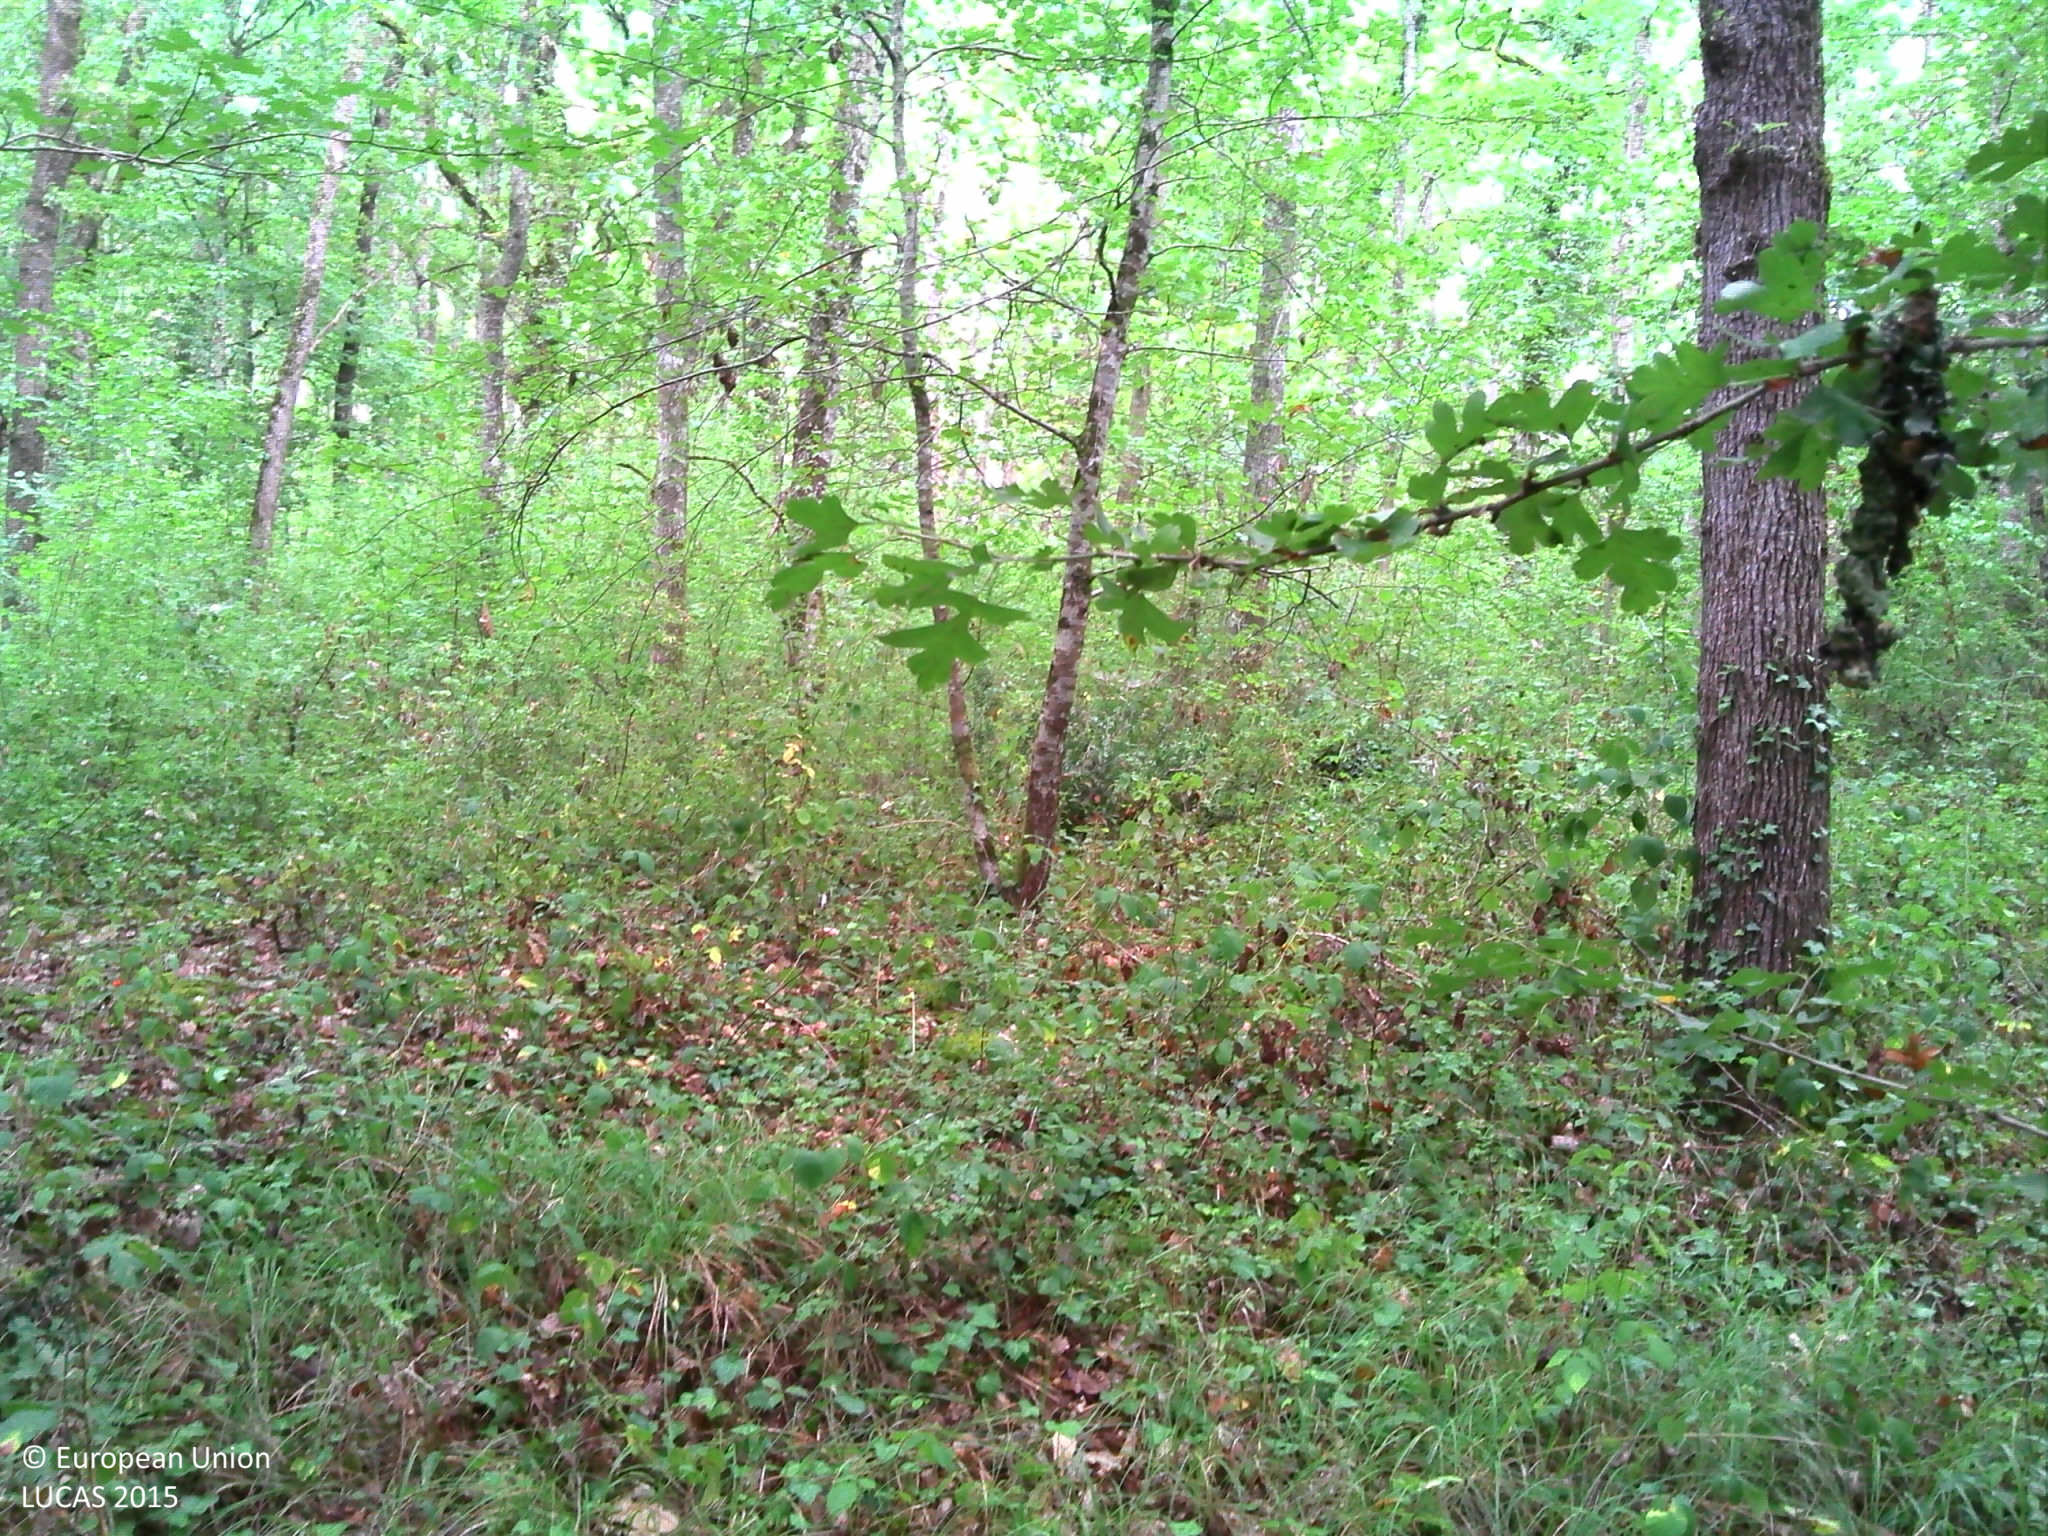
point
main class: Woodland
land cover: Broadleaved woodland
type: thermophilous deciduous forest
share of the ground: > 75 %
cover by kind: broadleaved forest trees 85 %, herbaceous plants 15 %
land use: Forestry
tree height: > 5 m
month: August
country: FR
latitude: 44.2376
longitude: 0.6667
